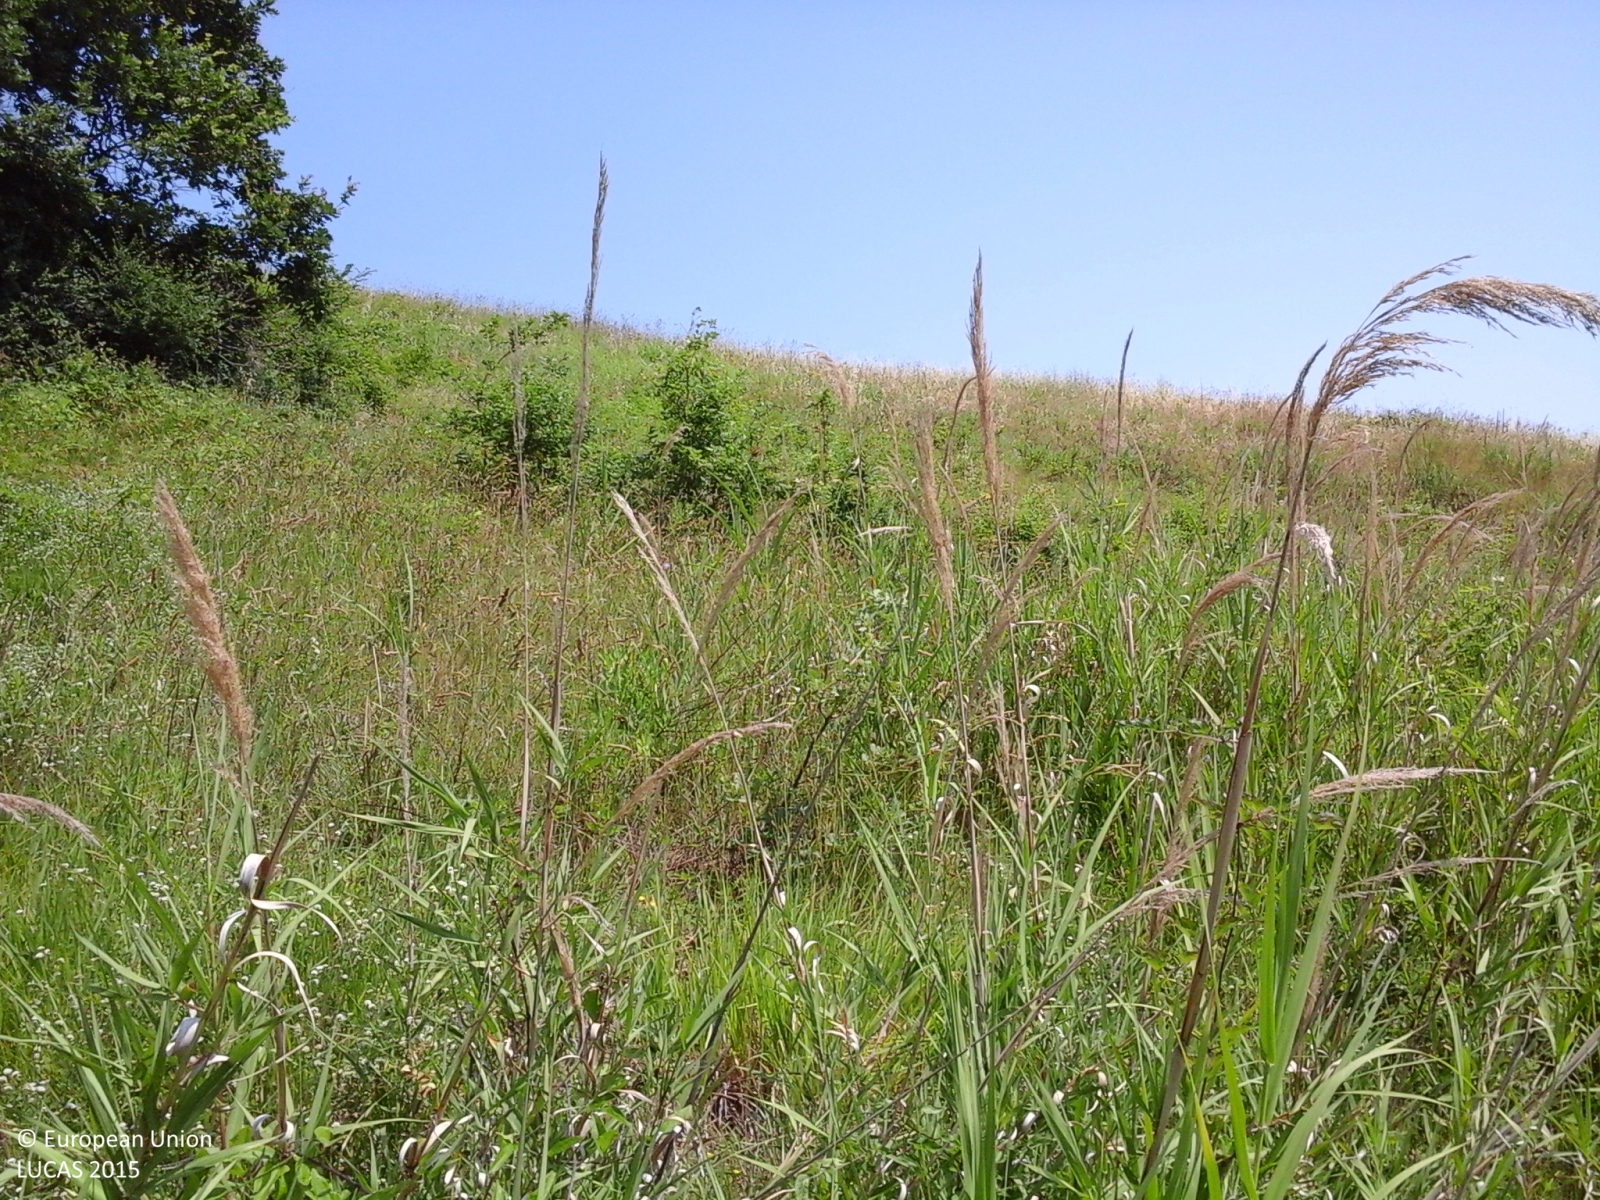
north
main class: Shrubland
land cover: Shrubland with sparse tree cover
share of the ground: > 75 %
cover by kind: shrubs 70 %, herbaceous plants 25 %, broadleaved forest trees 5 %
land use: Semi-natural and natural areas not in use
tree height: < 5 m
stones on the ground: < 10 %
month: June
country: IT
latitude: 44.2067
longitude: 11.9103
